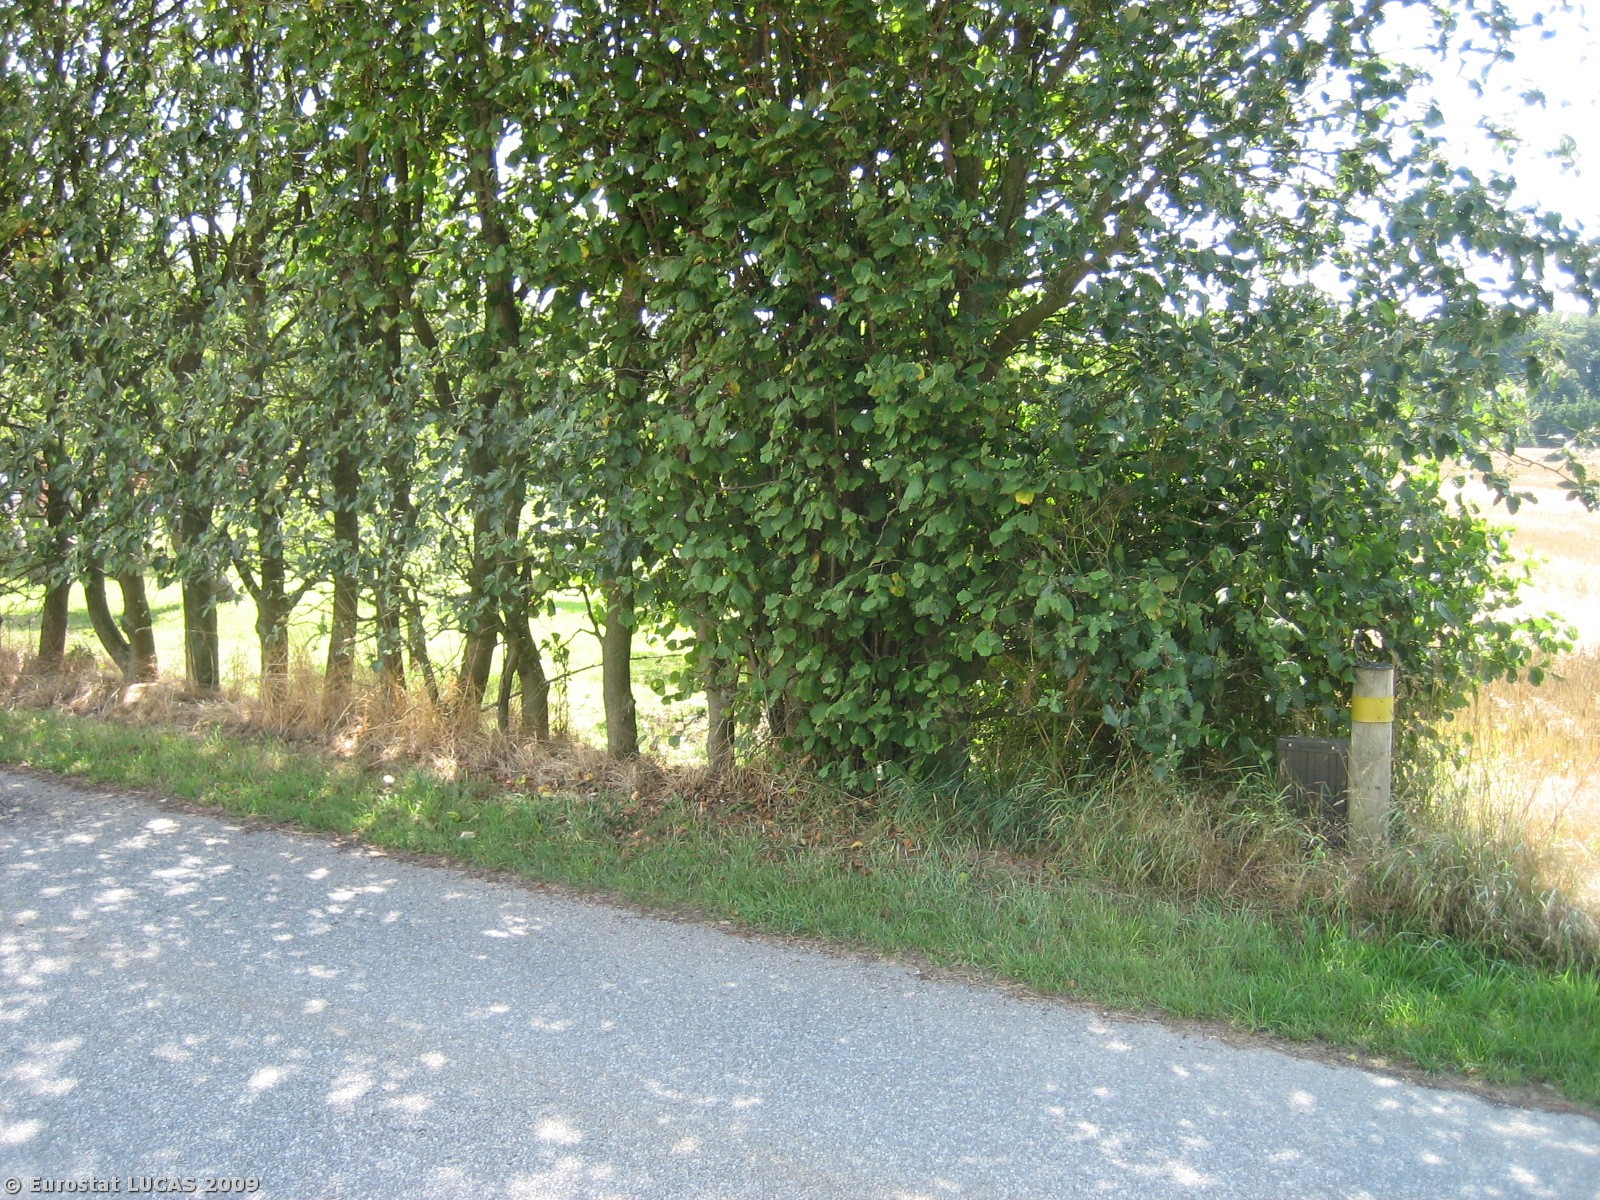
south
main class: Cropland
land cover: Rye
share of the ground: > 75 %
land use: Agriculture (excluding fallow land and kitchen gardens)
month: July
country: DK
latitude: 55.5047
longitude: 10.0158
